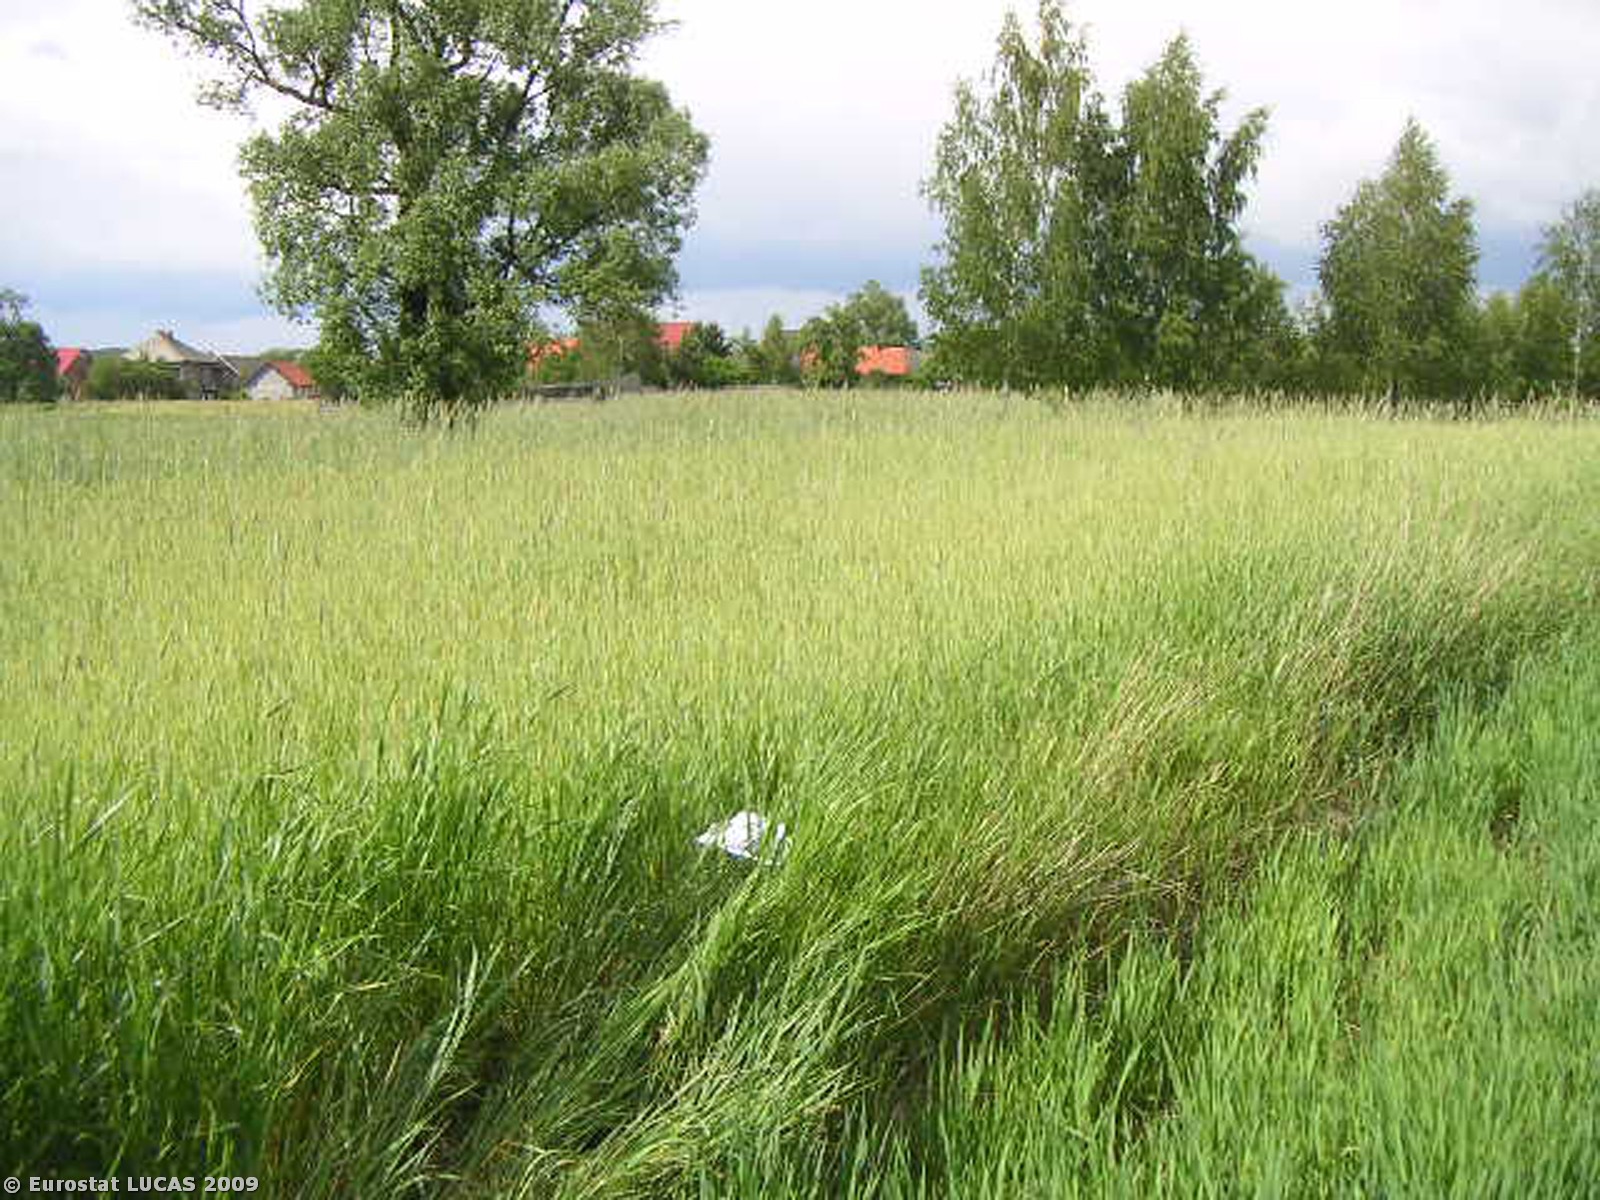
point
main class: Cropland
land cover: Barley
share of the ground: 50 - 75 %
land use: Agriculture (excluding fallow land and kitchen gardens)
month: May
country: PL
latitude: 49.9923
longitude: 19.6393
